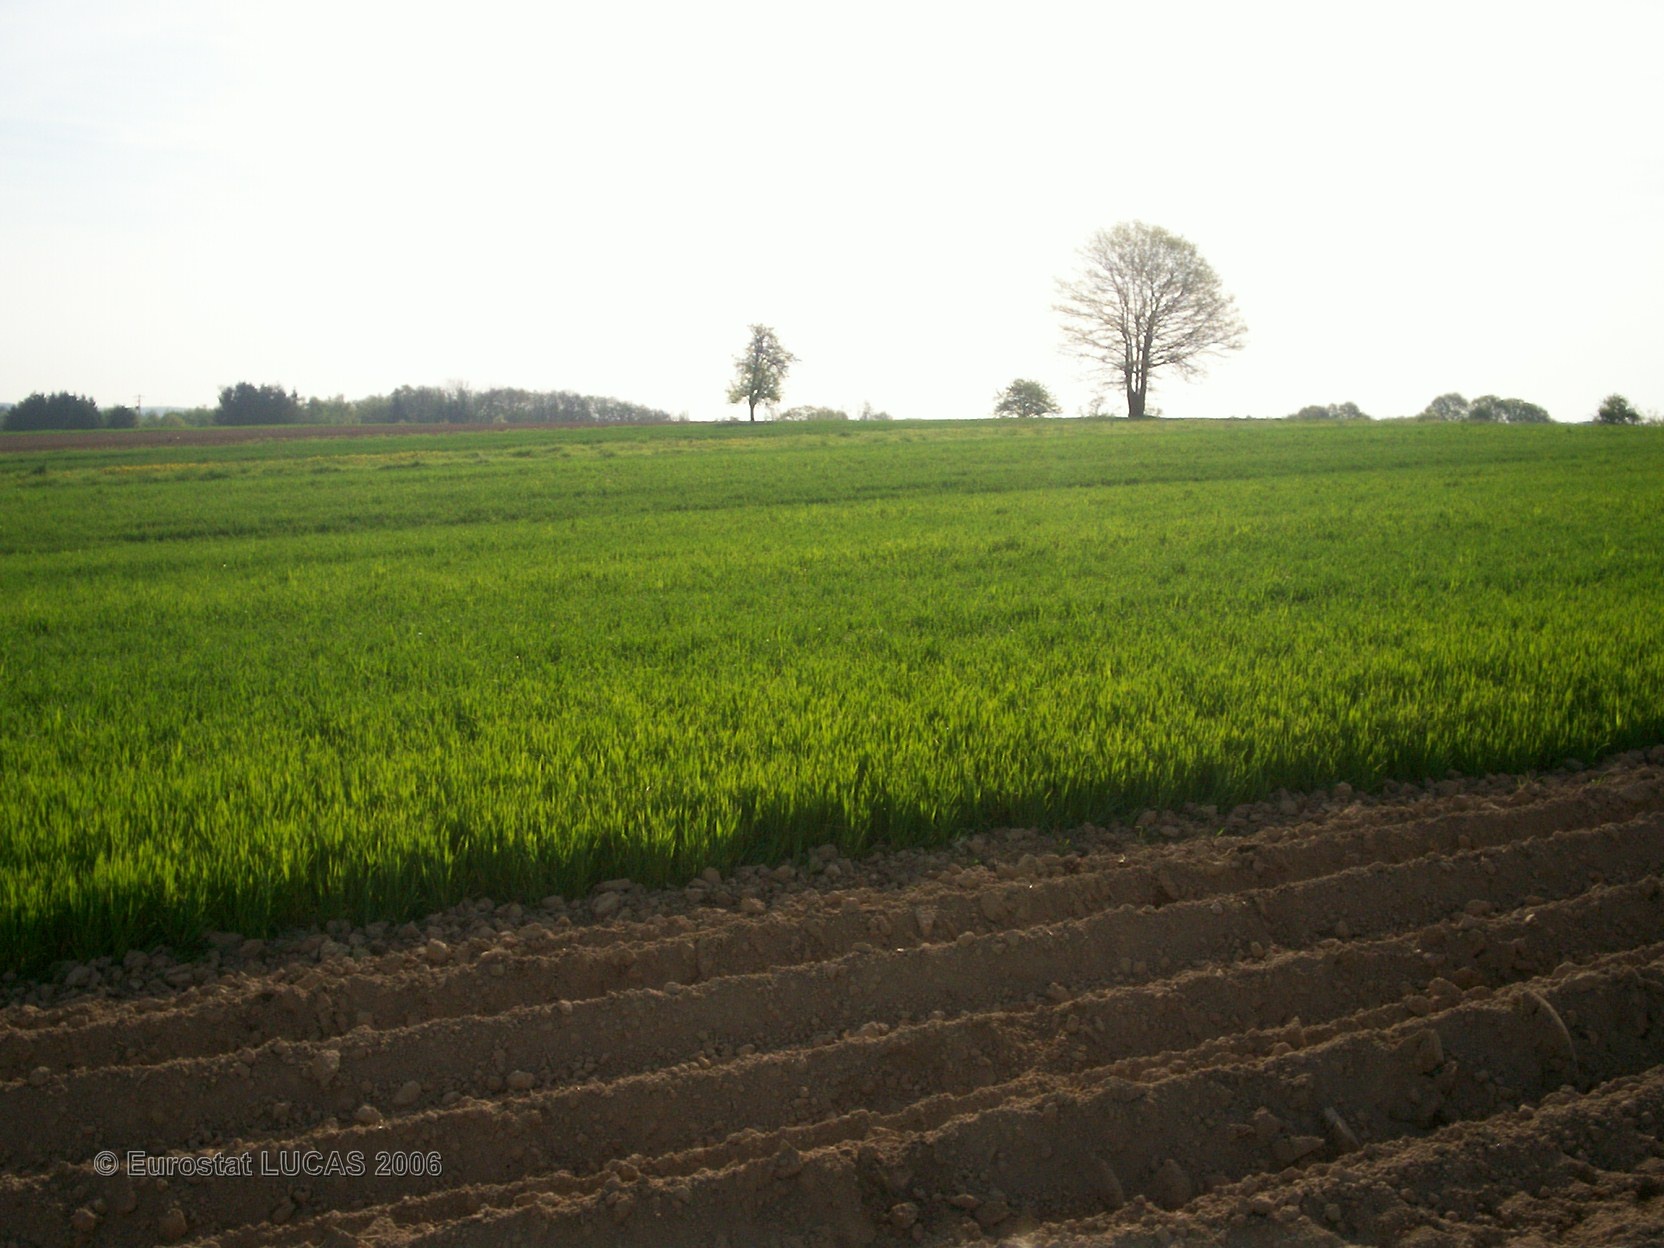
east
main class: Cropland
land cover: Maize
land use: Agriculture (excluding fallow land and kitchen gardens)
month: May
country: FR
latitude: 49.0089
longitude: 6.9243
